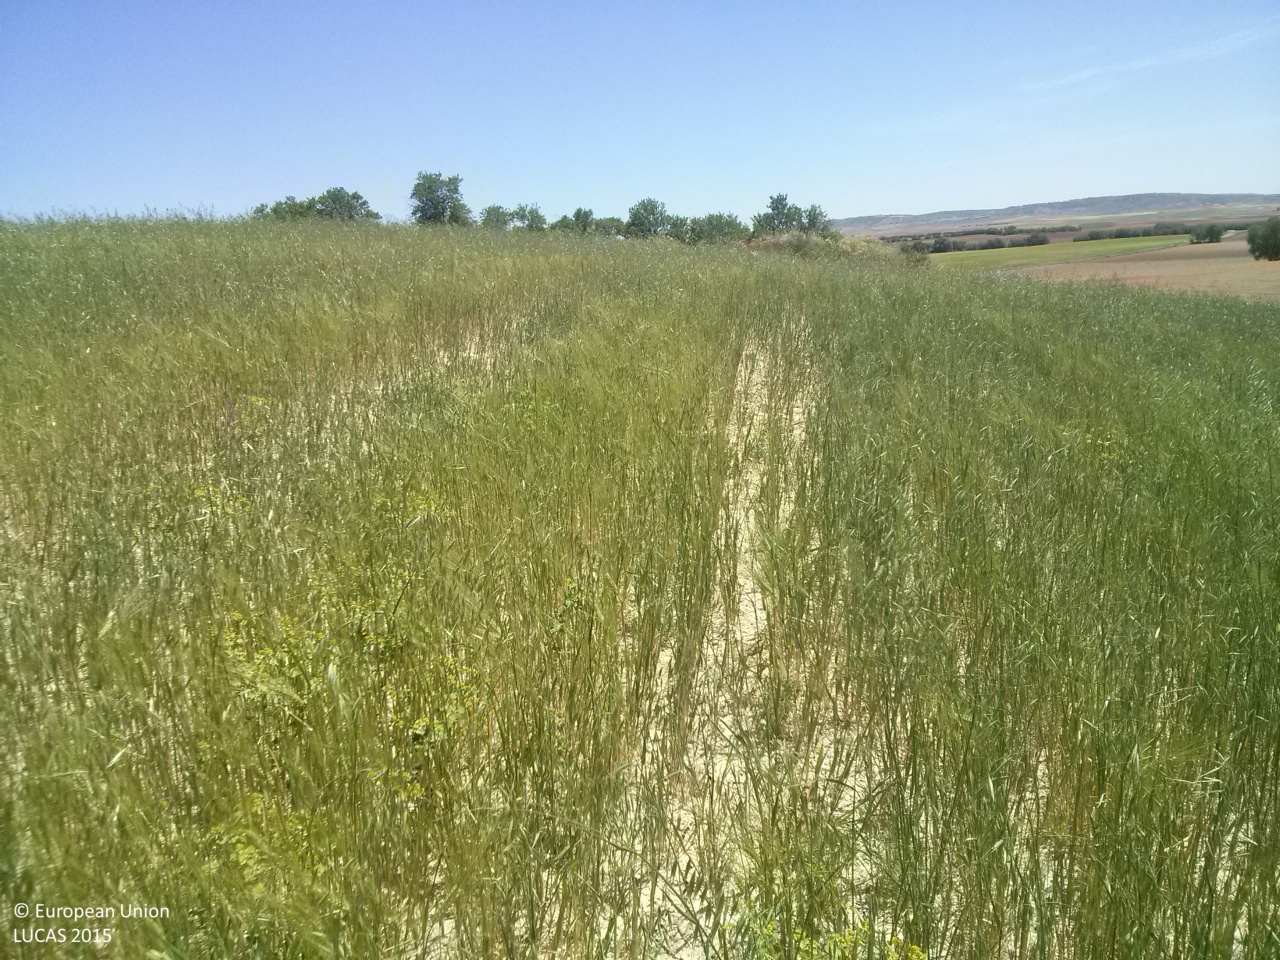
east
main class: Cropland
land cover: Mixed cereals for fodder
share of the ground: > 75 %
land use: Agriculture (excluding fallow land and kitchen gardens)
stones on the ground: < 10 %
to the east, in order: Mixed cereals for fodder; Sunflower; Groves; Dry pulses
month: May
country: ES
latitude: 39.9867
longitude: -2.7033
